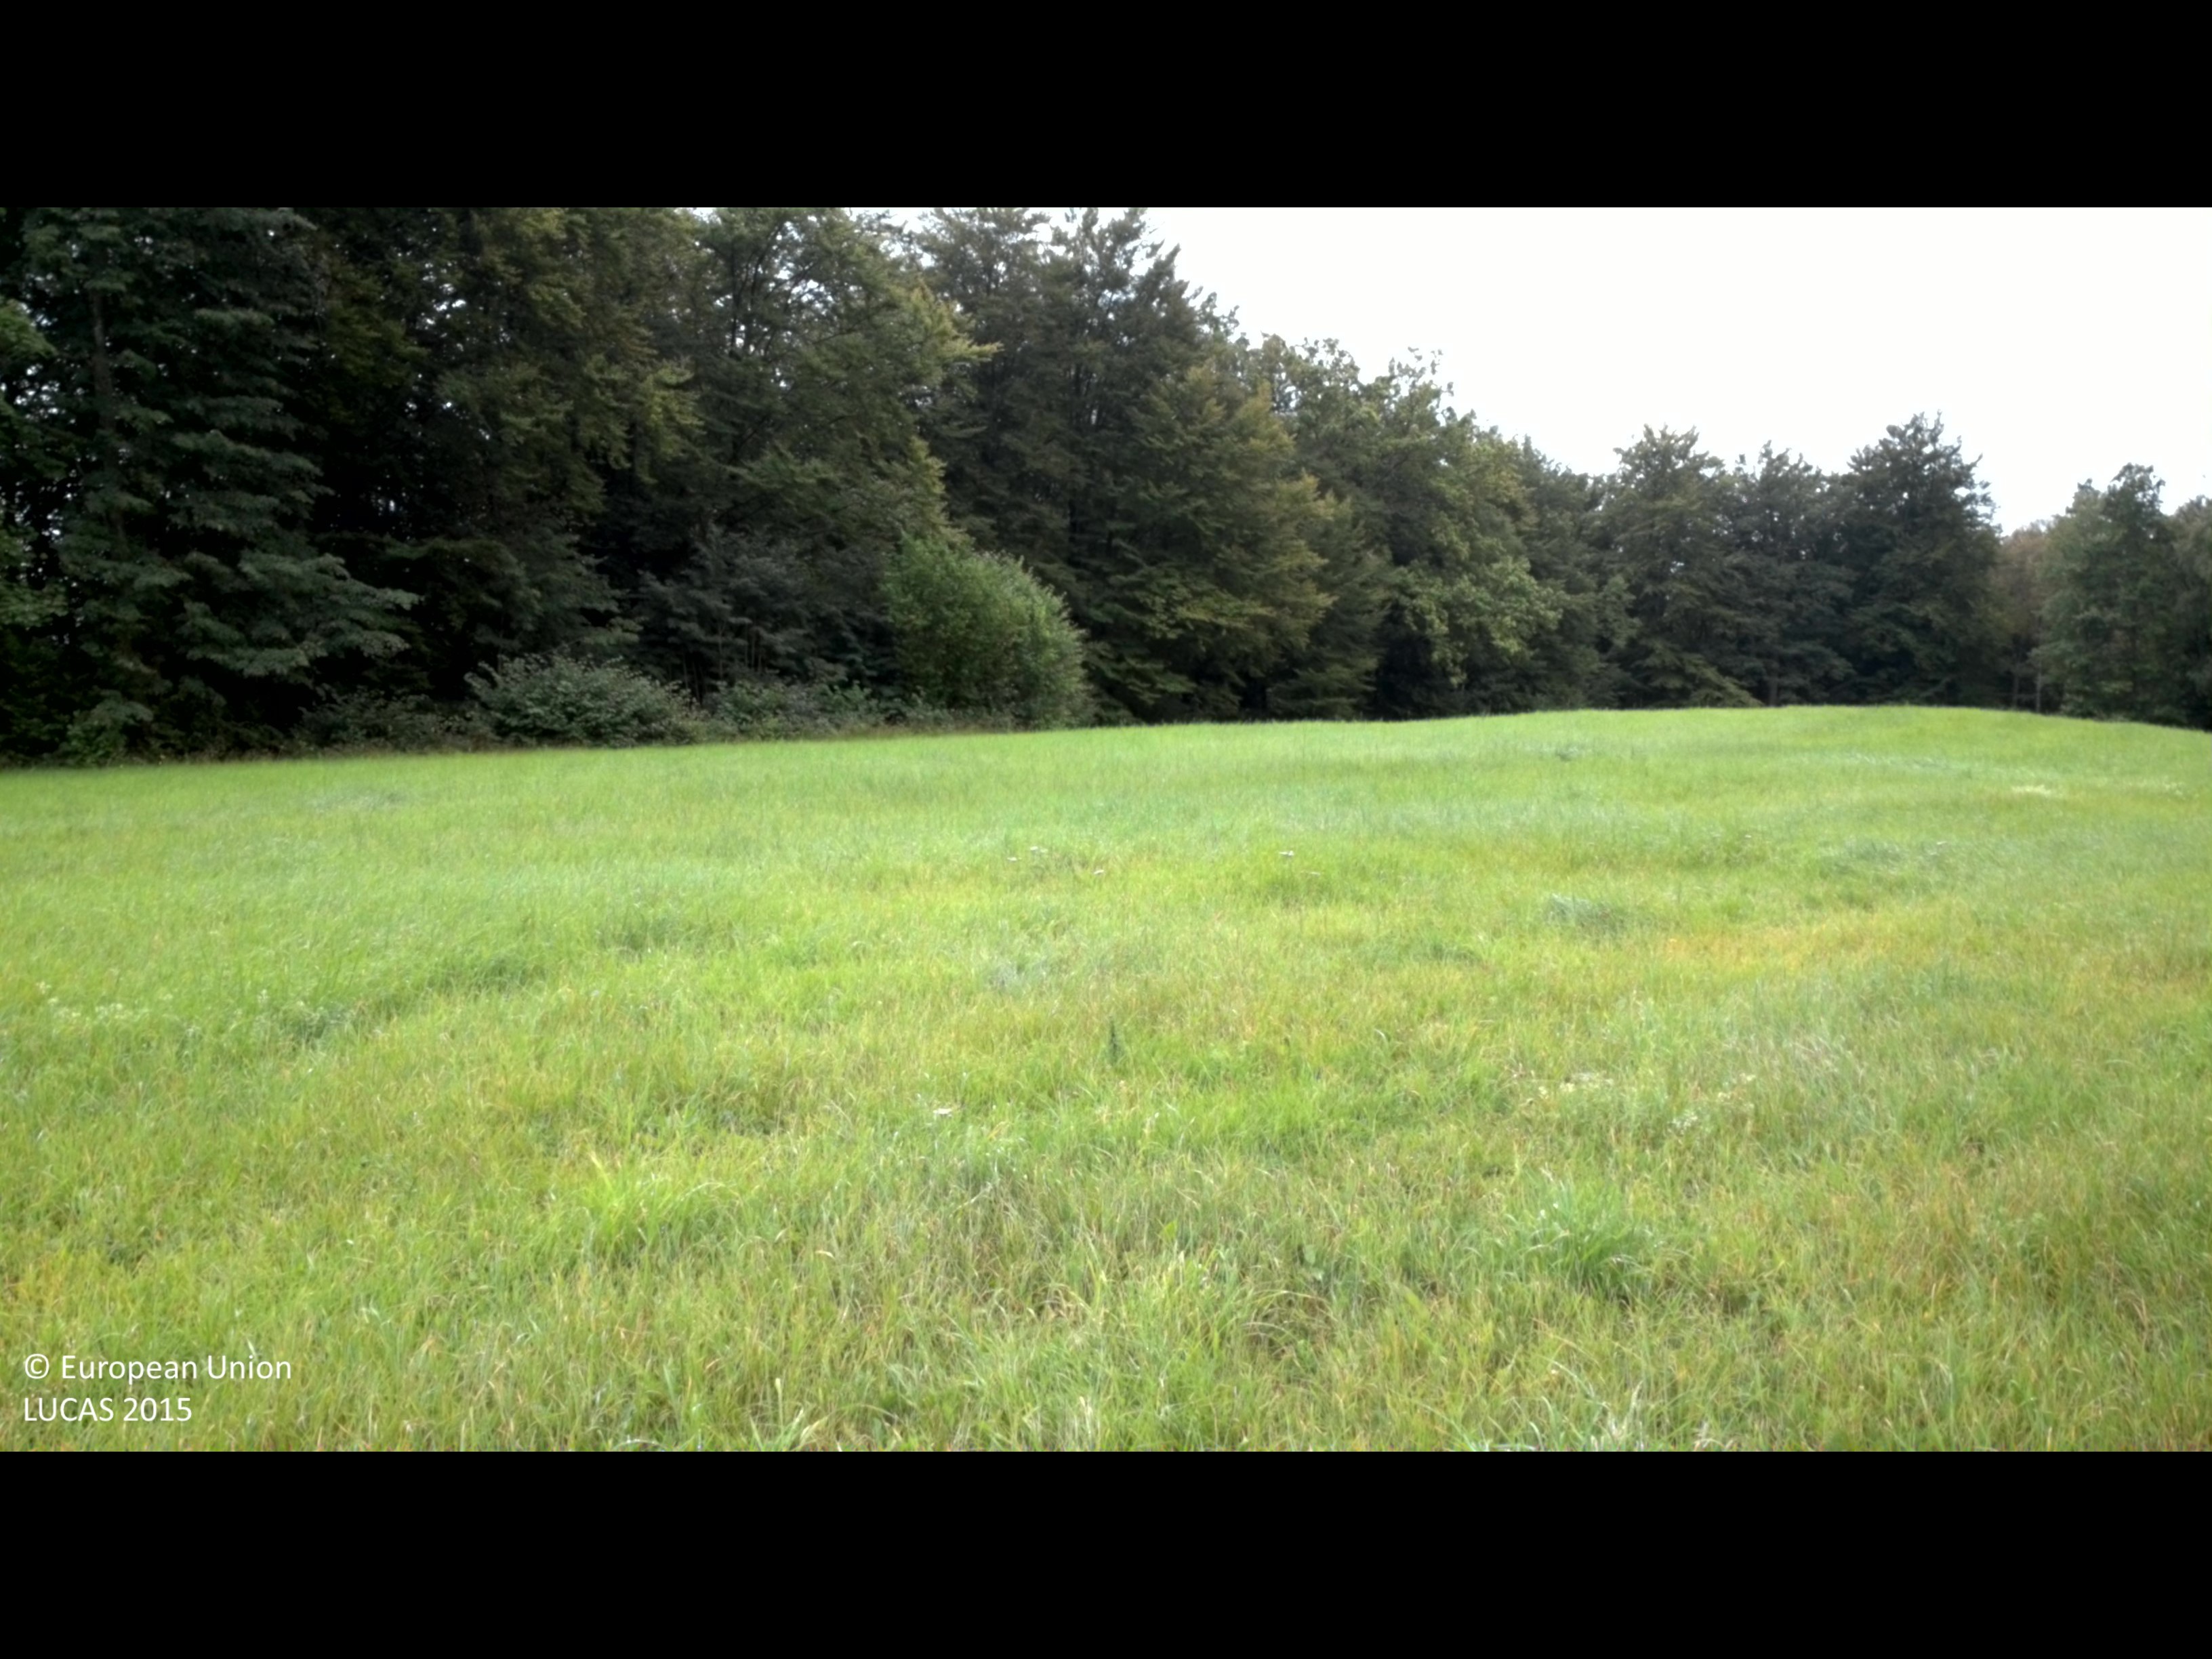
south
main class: Grassland
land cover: Grassland without tree/shrub cover
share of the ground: > 75 %
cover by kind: herbaceous plants 100 %
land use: Agriculture (excluding fallow land and kitchen gardens)
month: August
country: SE
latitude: 56.9934
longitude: 13.2060
